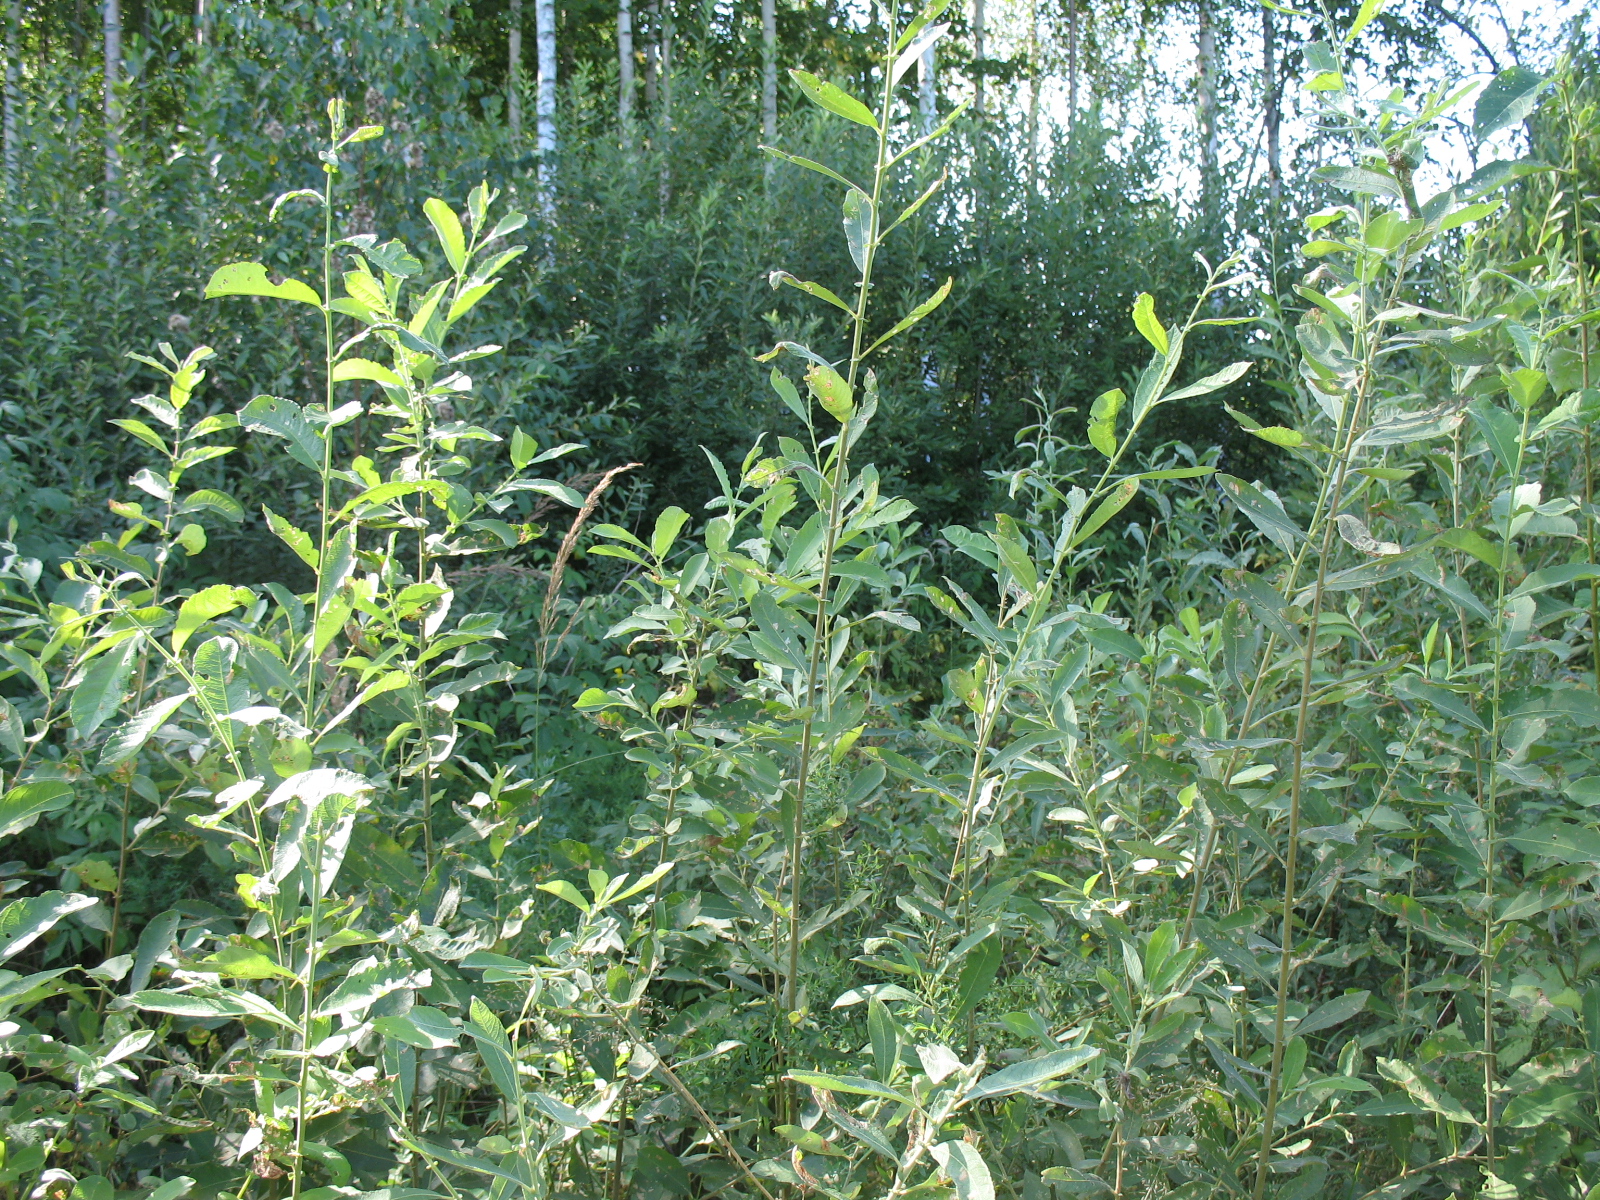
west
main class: Woodland
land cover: Broadleaved woodland
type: non-riverine alder, birch or aspen forest
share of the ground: 50 - 75 %
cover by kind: broadleaved forest trees 55 %, herbaceous plants 30 %, shrubs 15 %
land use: Forestry
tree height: < 5 m
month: August
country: LV
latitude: 56.4190
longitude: 26.0377
